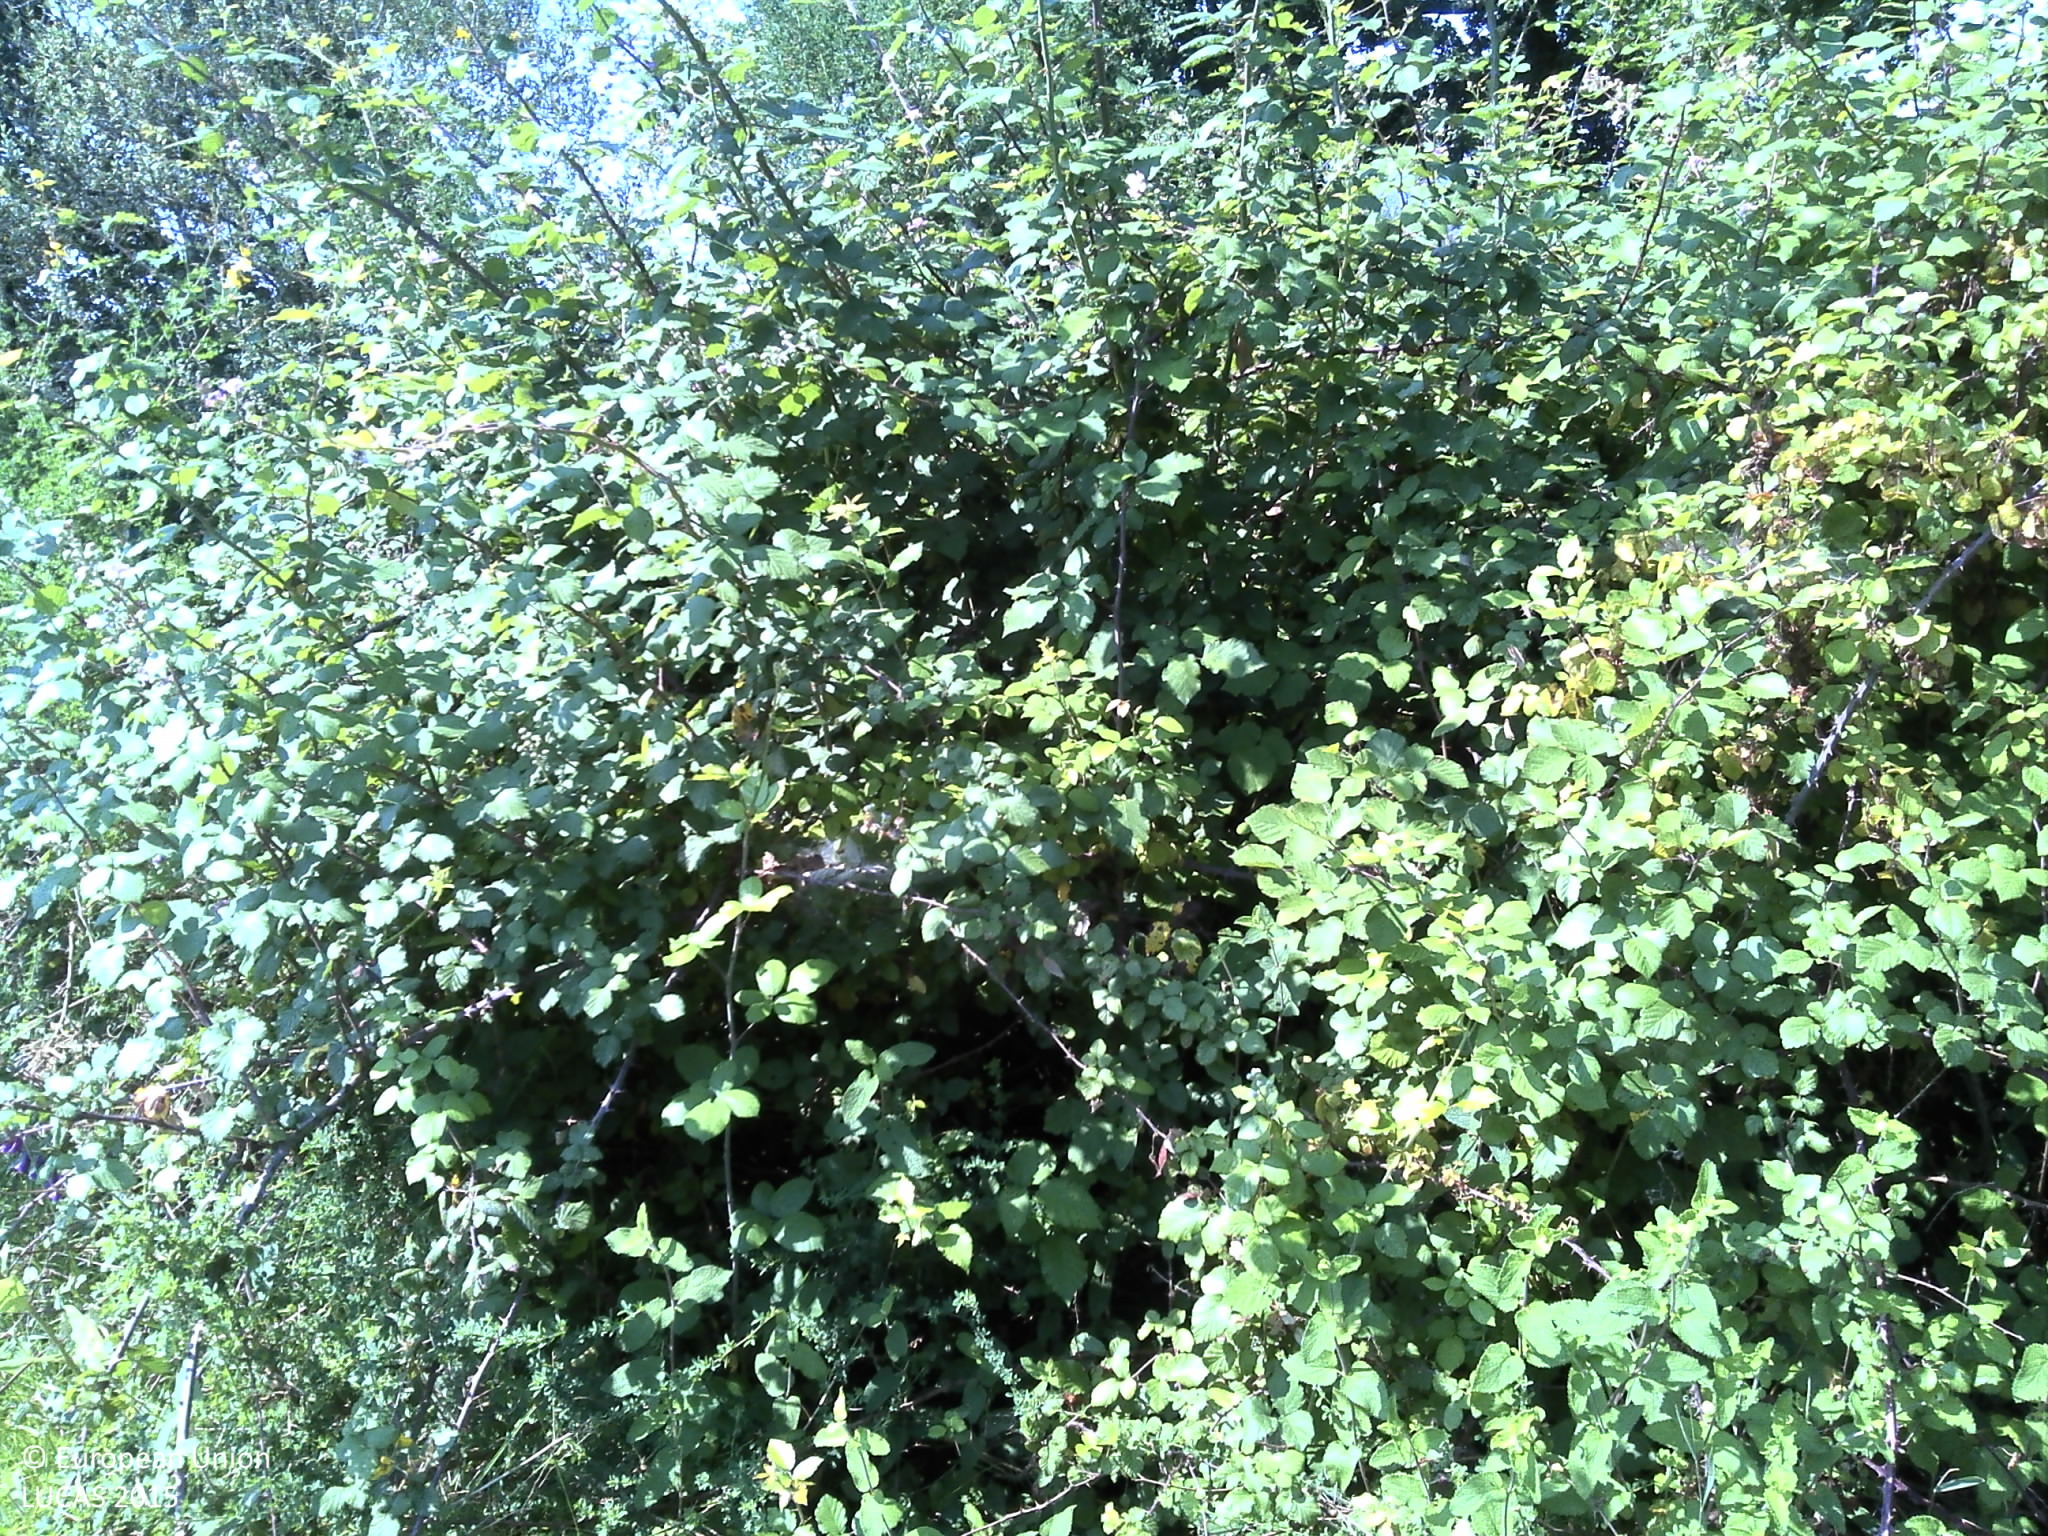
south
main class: Grassland
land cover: Grassland with sparse tree/shrub cover
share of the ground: 50 - 75 %
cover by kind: herbaceous plants 75 %, shrubs 10 %, unconsolidated bare surface 10 %, broadleaved forest trees 5 %
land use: Agriculture (excluding fallow land and kitchen gardens)
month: June
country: PT
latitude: 41.8681
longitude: -8.4361
